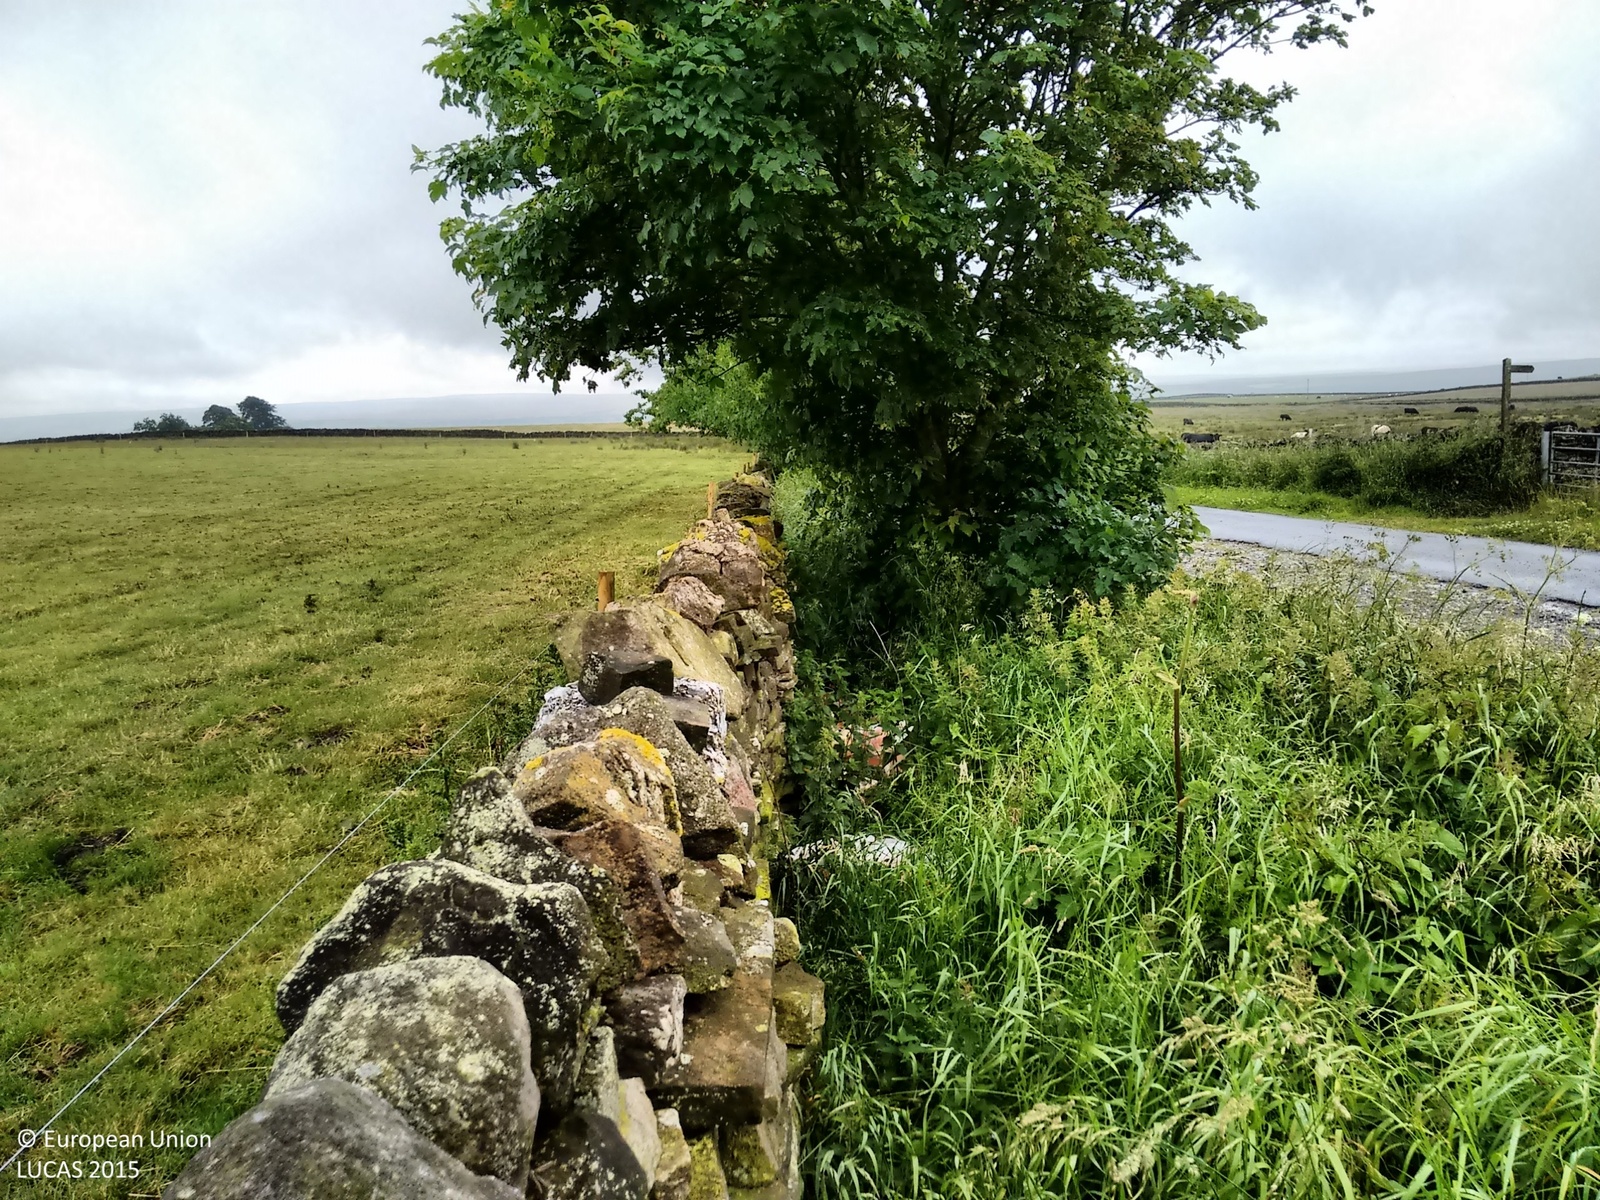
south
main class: Grassland
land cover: Grassland without tree/shrub cover
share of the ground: > 75 %
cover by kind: herbaceous plants 100 %
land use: Agriculture (excluding fallow land and kitchen gardens)
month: July
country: GB
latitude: 54.5894
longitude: -1.9553
